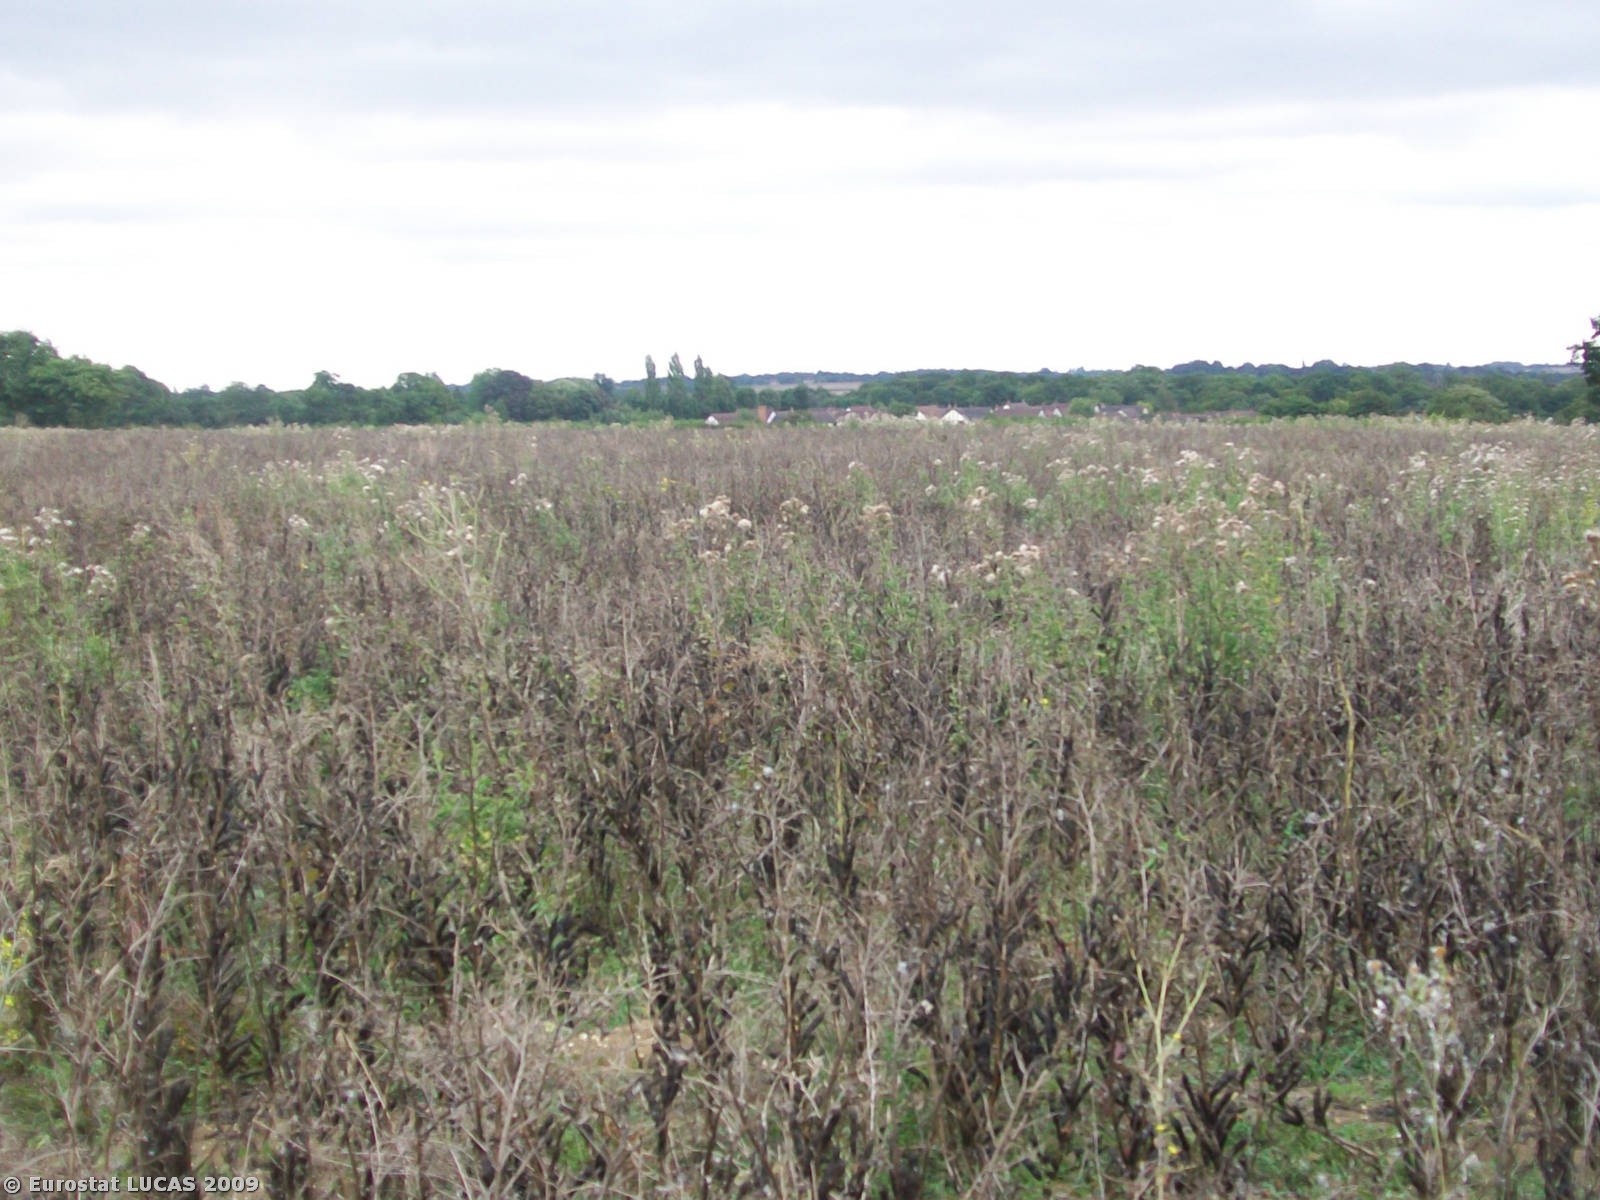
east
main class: Cropland
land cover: Dry pulses
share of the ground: > 75 %
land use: Agriculture (excluding fallow land and kitchen gardens)
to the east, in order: Dry pulses; Grass margins; Managed hedges; Ditches and canals; Grass margins; Common wheat
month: August
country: GB
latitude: 51.8015
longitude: 0.1219
